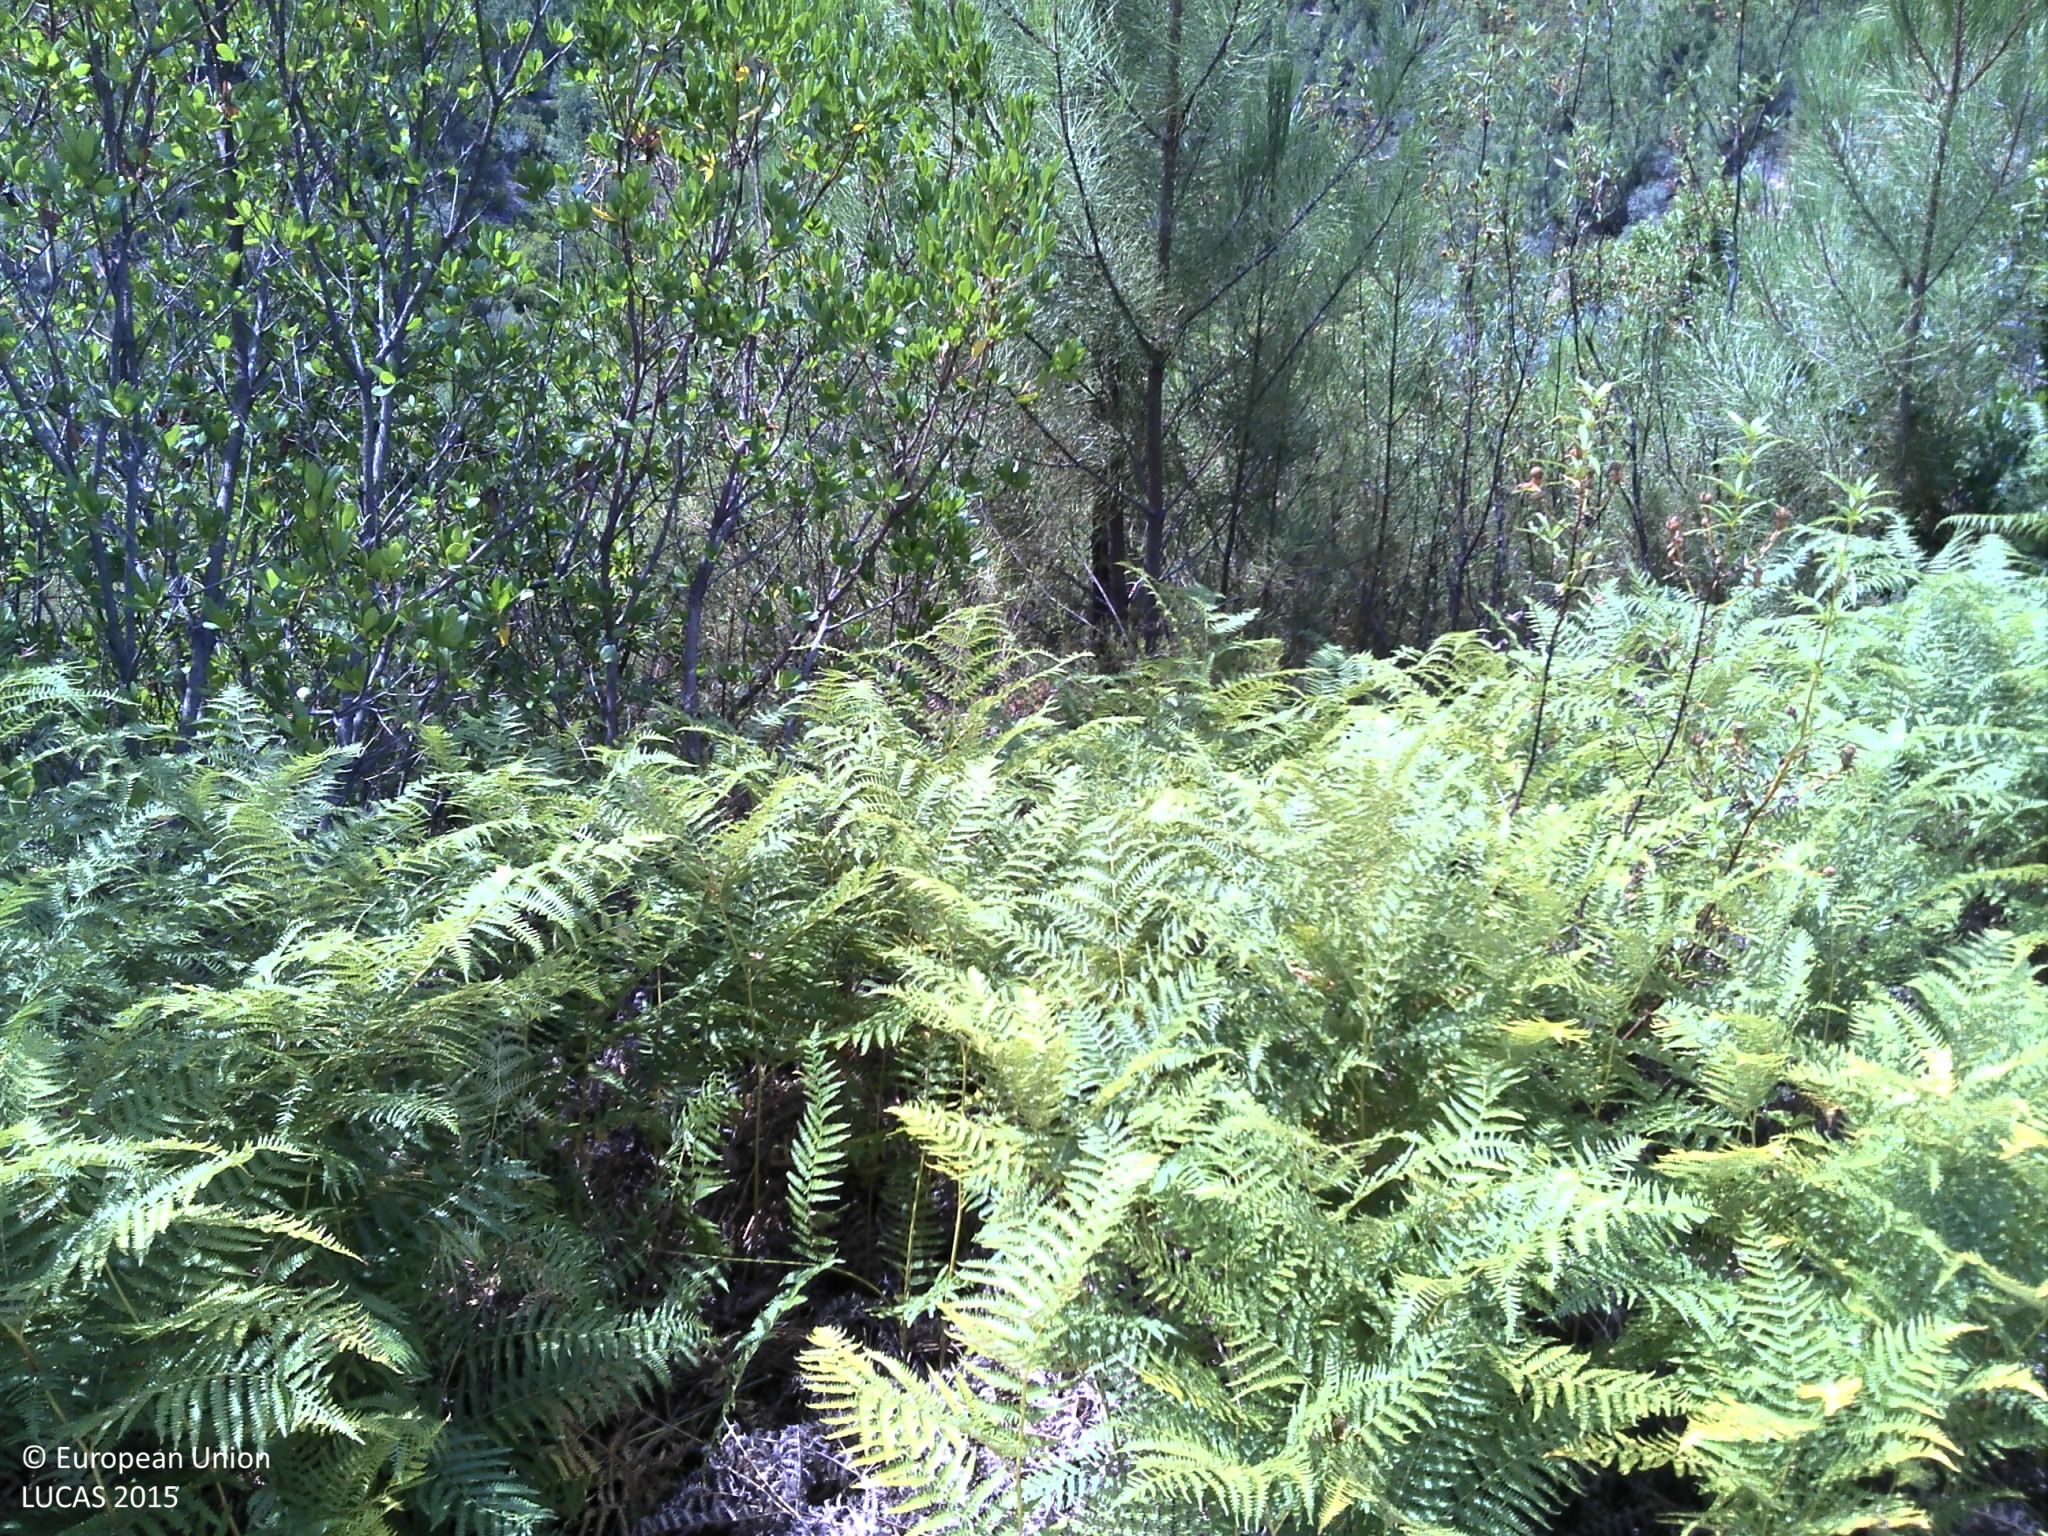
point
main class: Woodland
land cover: Pine dominated coniferous woodland
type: coniferous forest of the mediterranean region
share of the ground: 25 - 50 %
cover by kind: shrubs 50 %, coniferous forest trees 30 %, unconsolidated bare surface 20 %
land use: Forestry
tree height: < 5 m
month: July
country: PT
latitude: 39.8417
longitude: -7.8121
